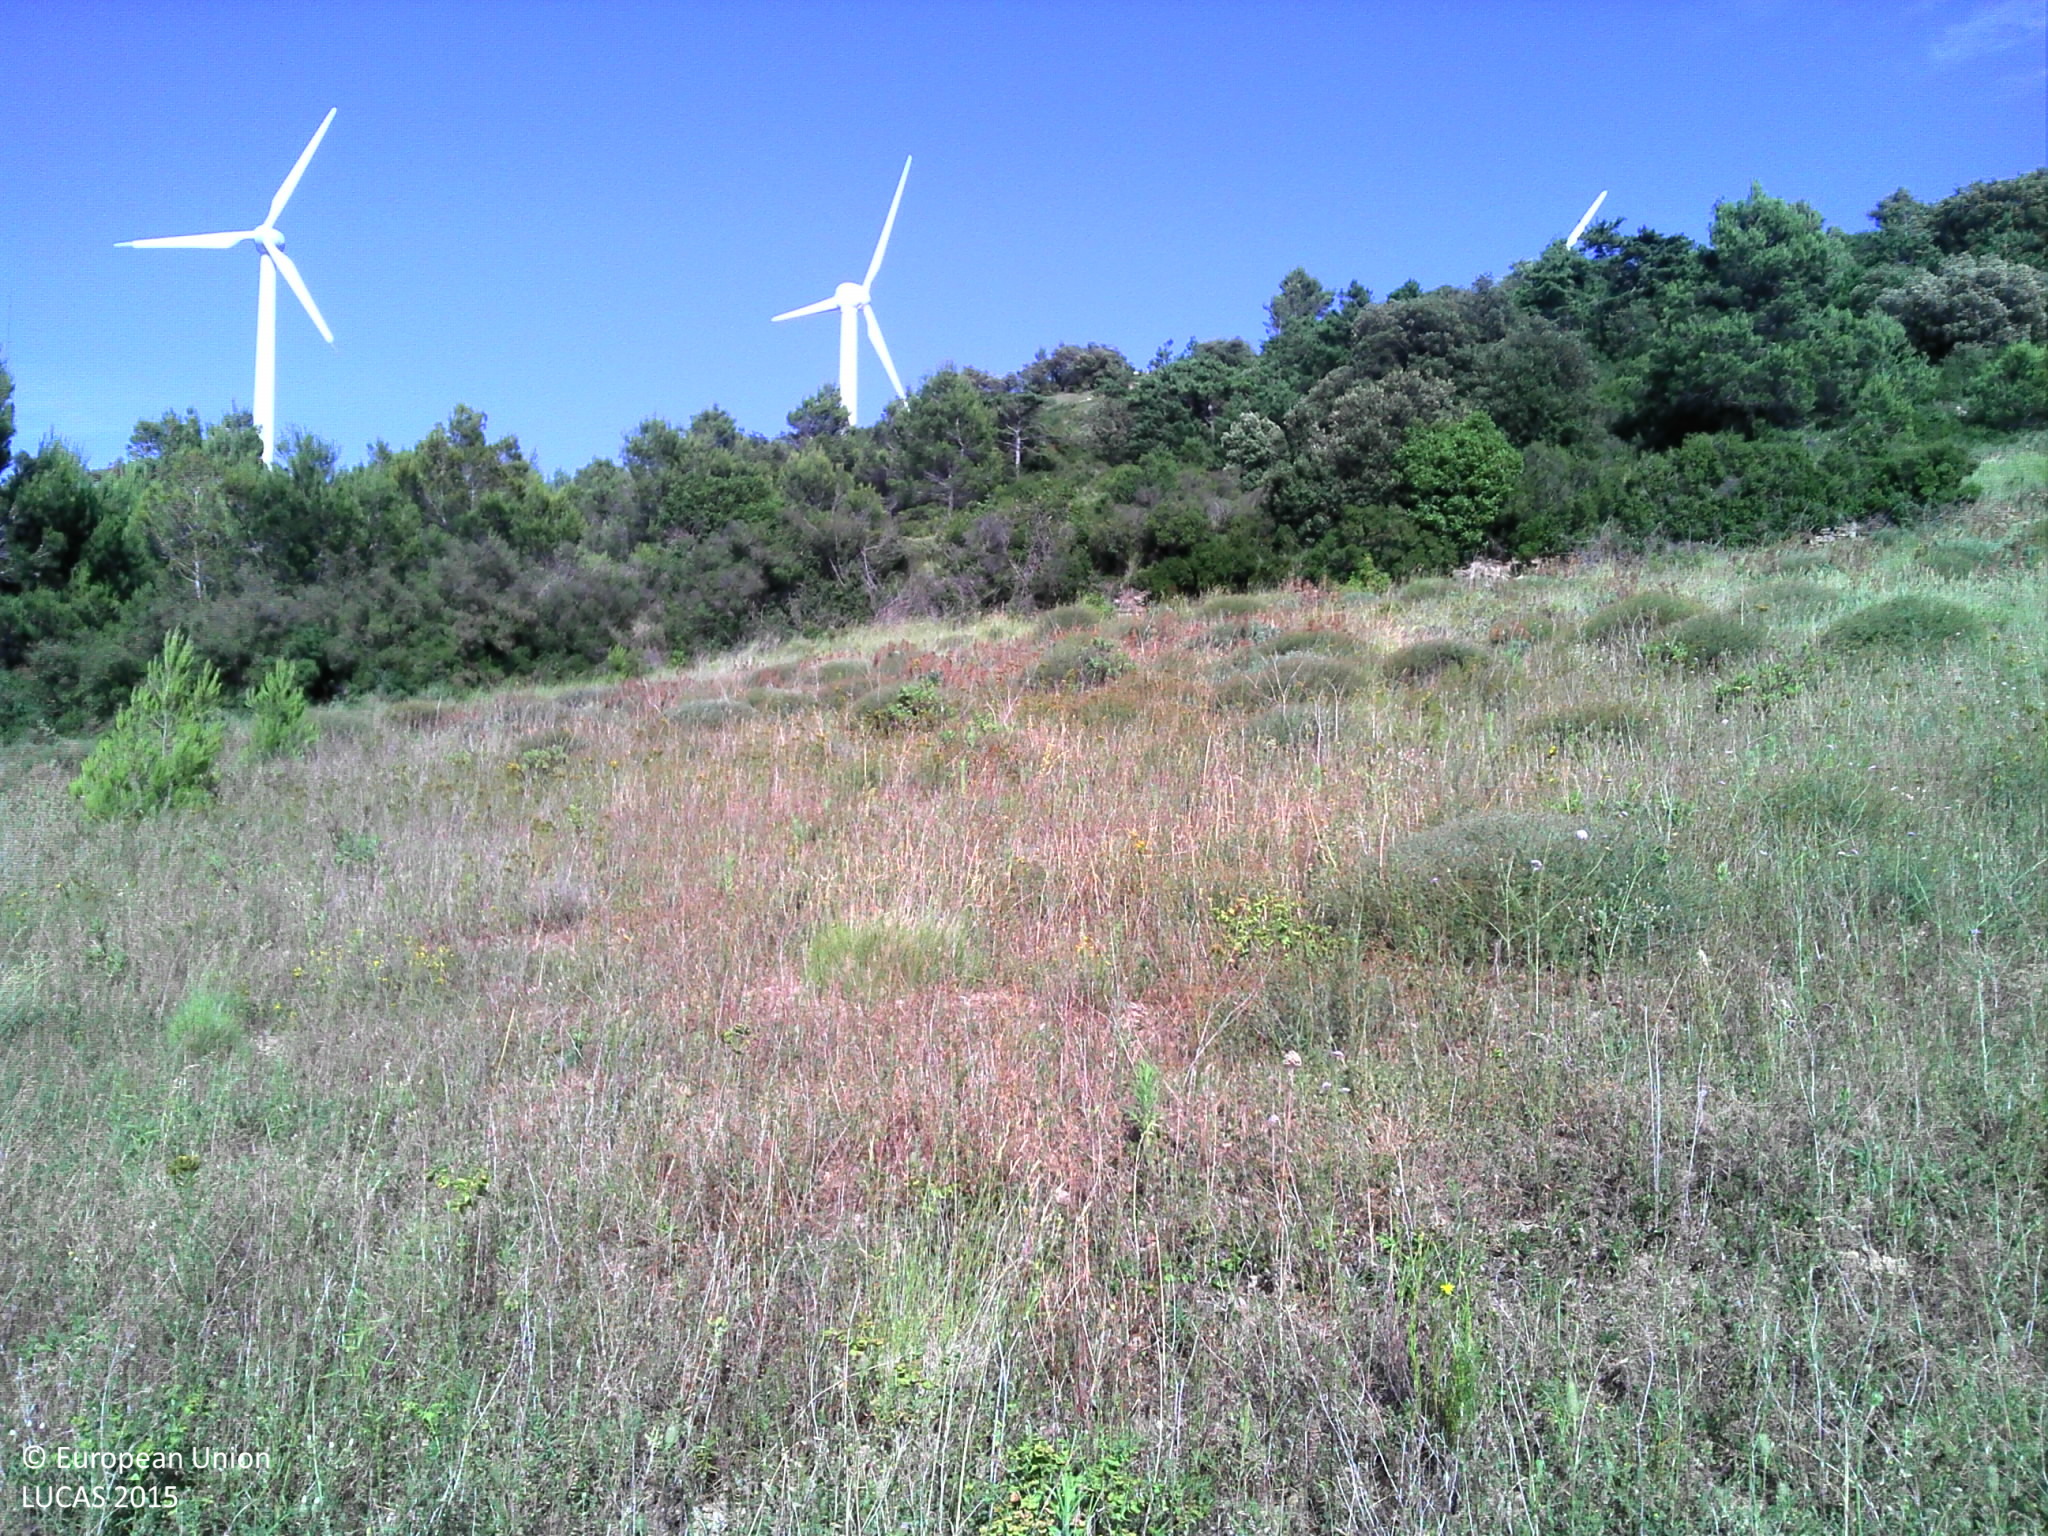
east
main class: Grassland
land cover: Spontaneously vegetated surfaces
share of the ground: > 75 %
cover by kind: herbaceous plants 95 %, shrubs 5 %
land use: Semi-natural and natural areas not in use
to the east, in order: Spontaneously vegetated surfaces; Shrubland with sparse tree cover; Tracks; Shrubland with sparse tree cover
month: June
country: FR
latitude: 43.2066
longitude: 2.7104
